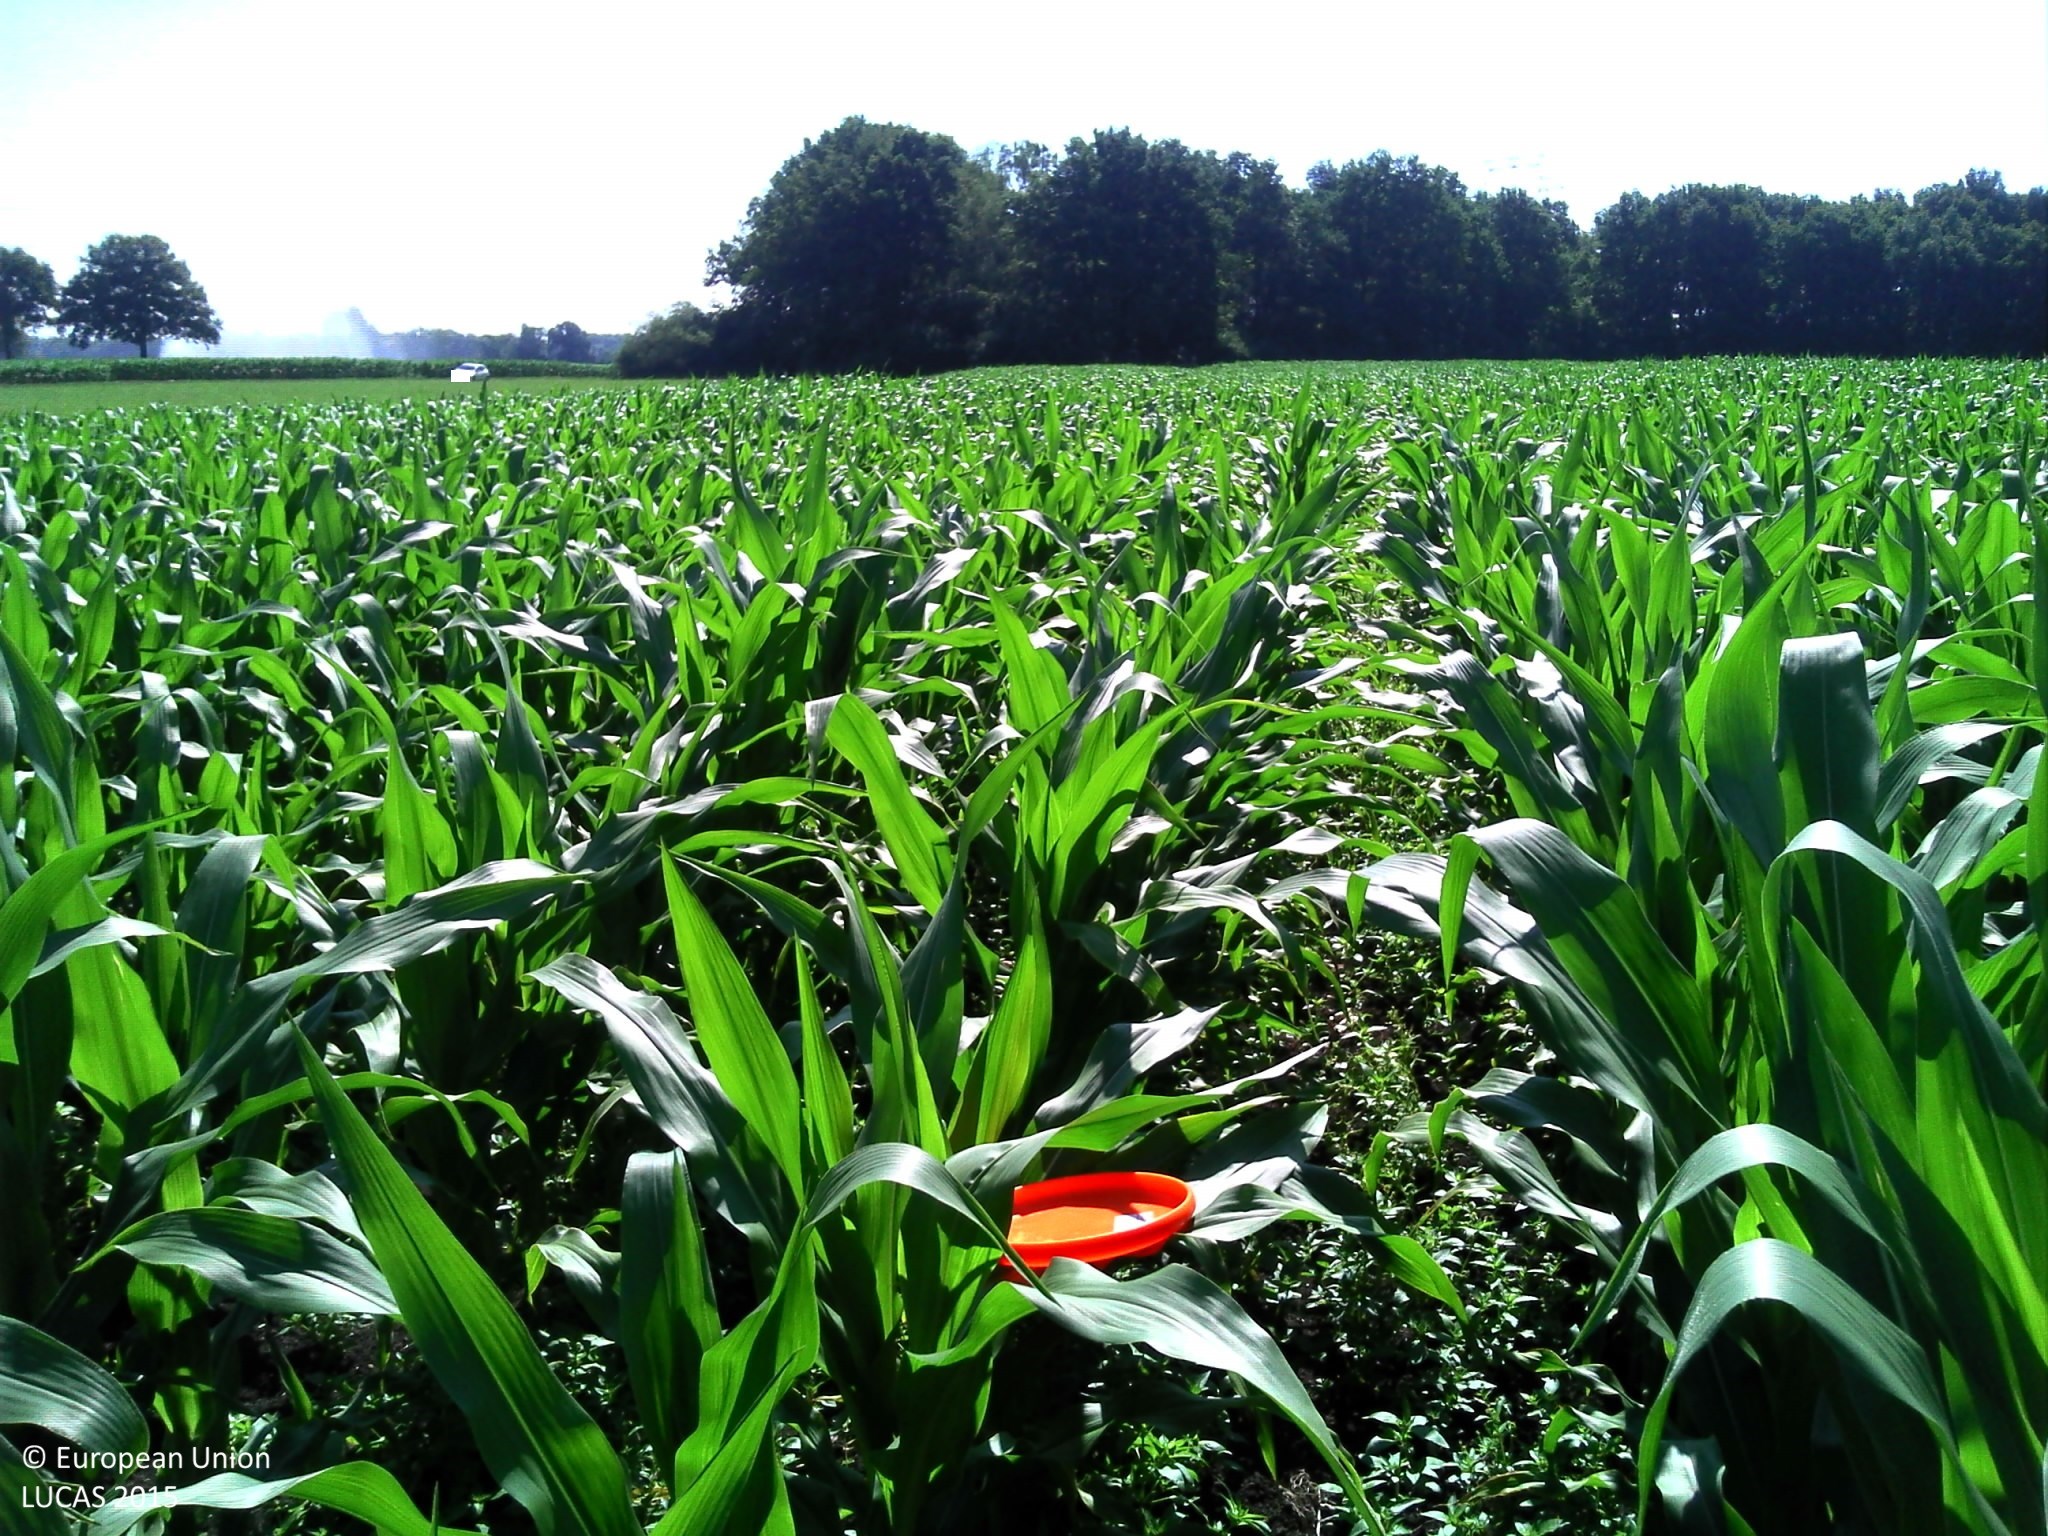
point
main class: Cropland
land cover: Maize
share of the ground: 50 - 75 %
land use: Agriculture (excluding fallow land and kitchen gardens)
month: June
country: FR
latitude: 48.1583
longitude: 7.4602
